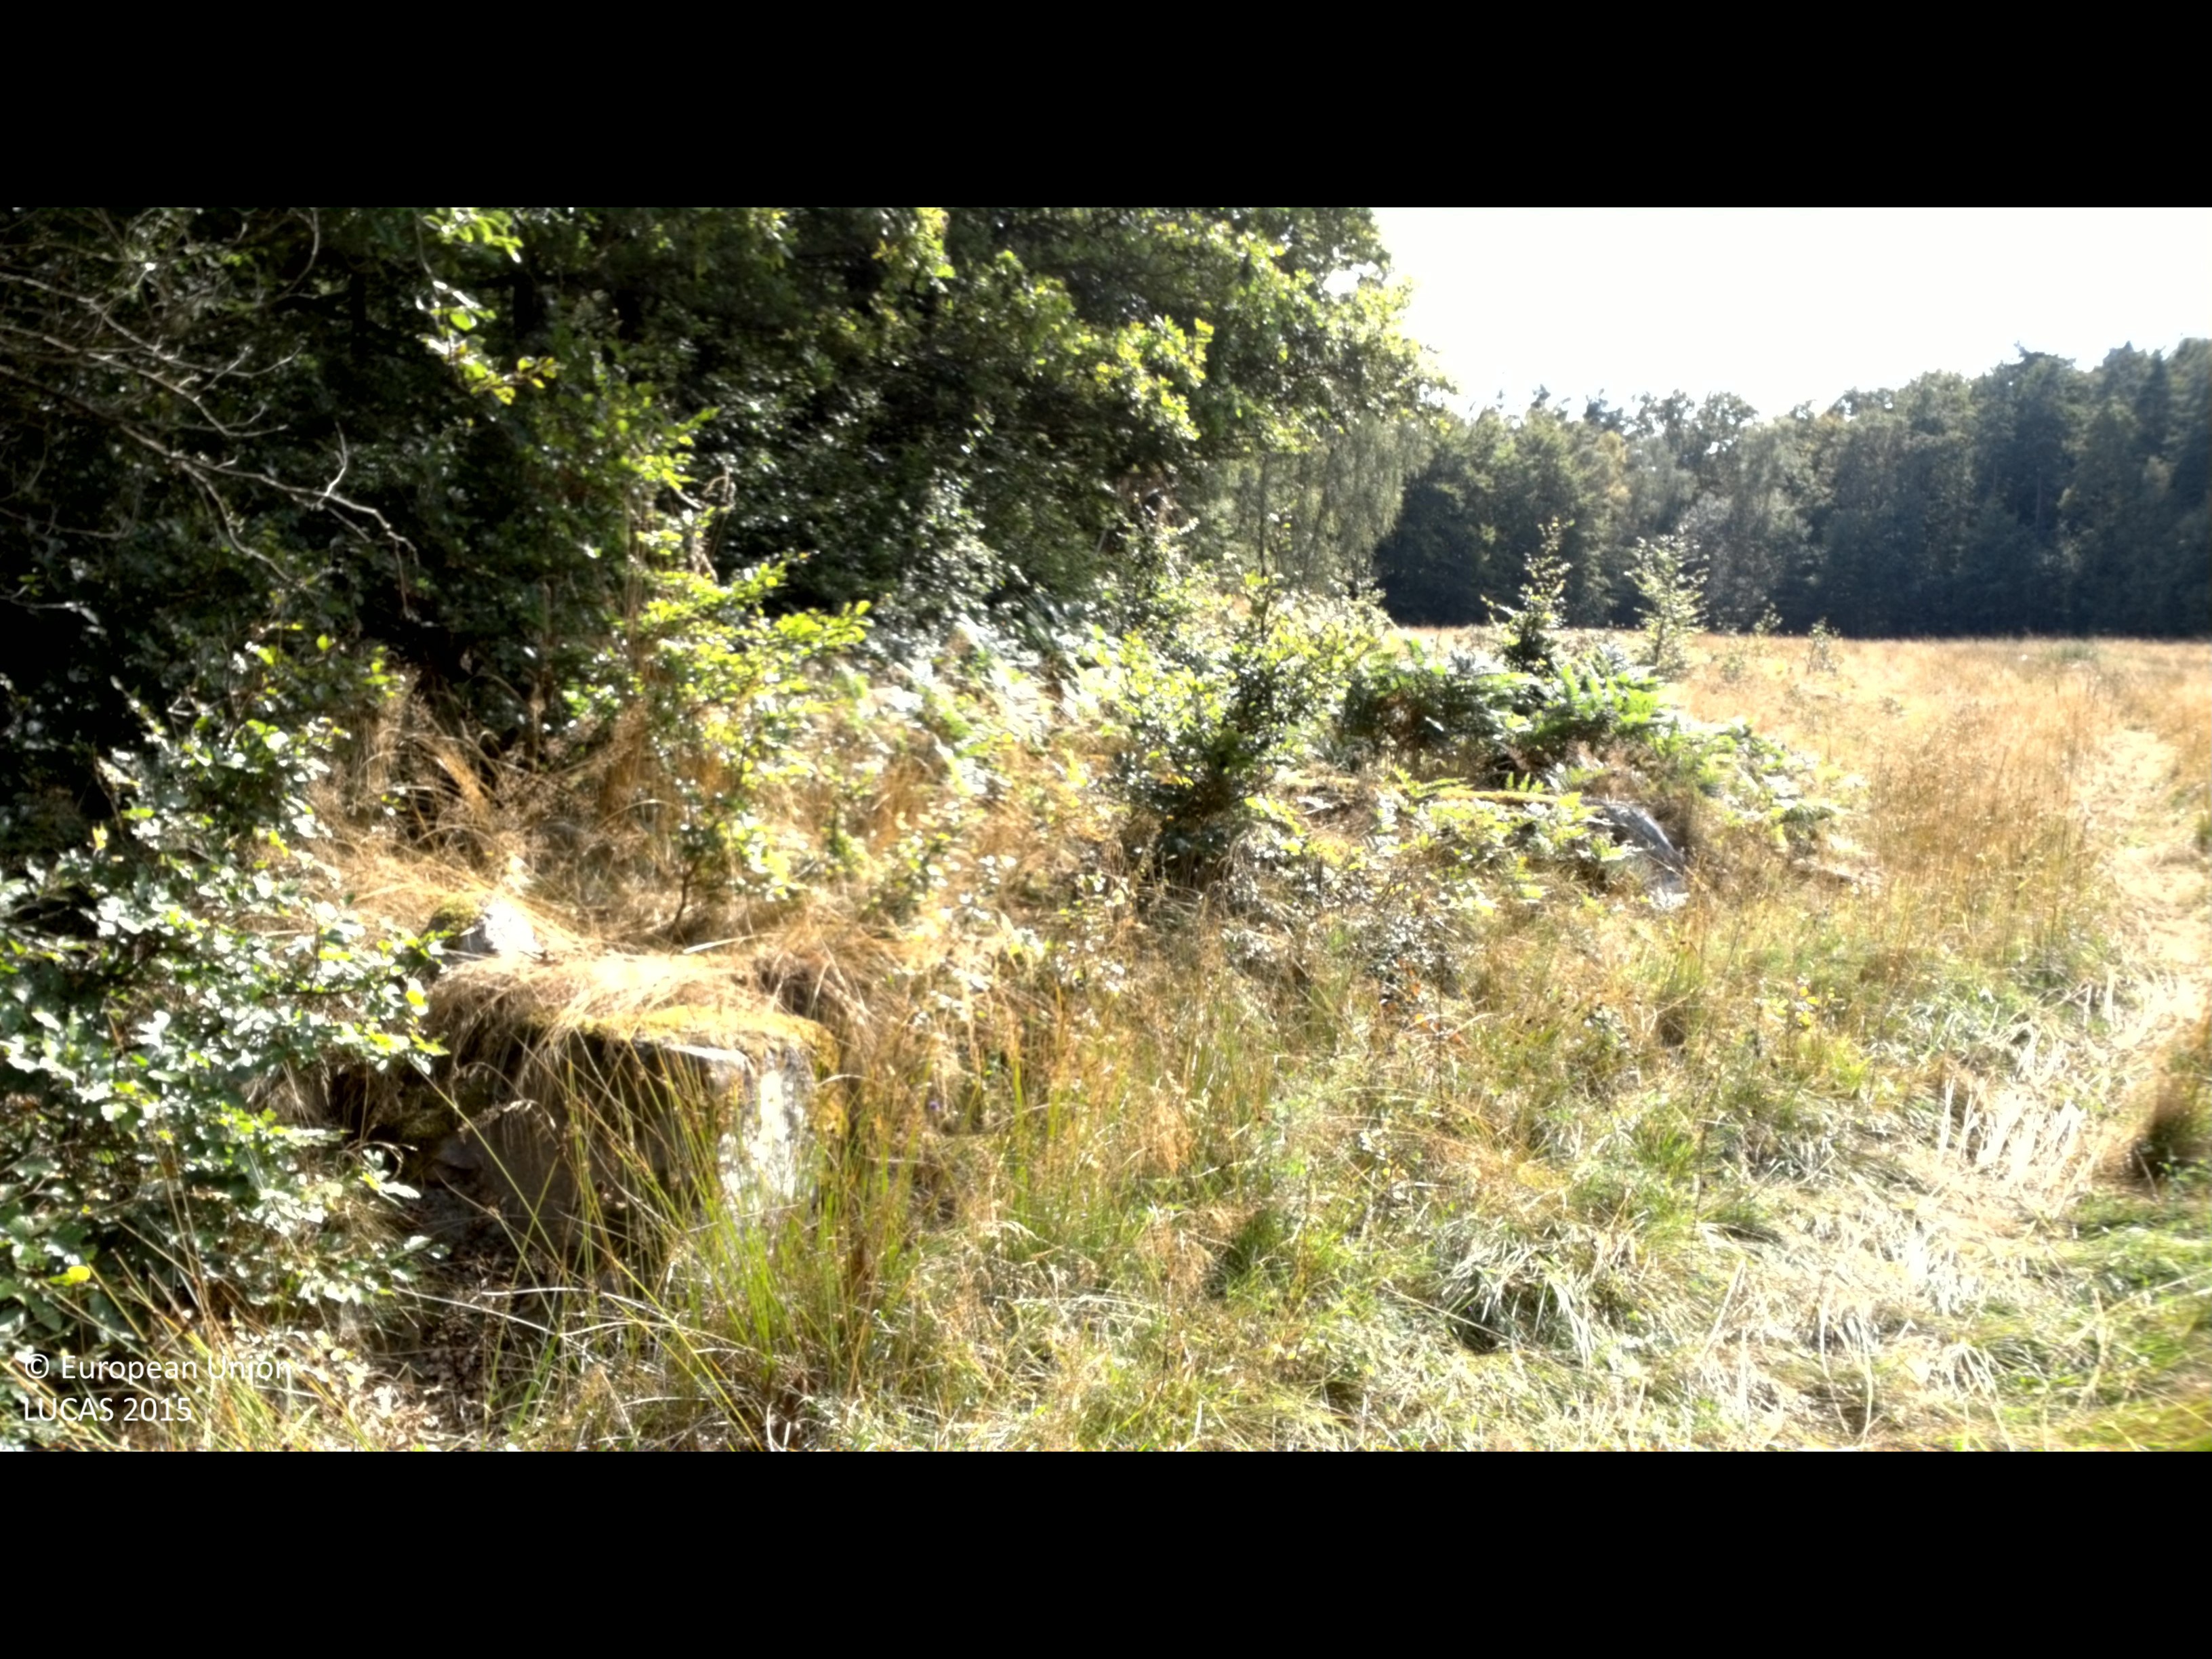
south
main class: Grassland
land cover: Grassland without tree/shrub cover
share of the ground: > 75 %
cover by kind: herbaceous plants 100 %
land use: Agriculture (excluding fallow land and kitchen gardens)
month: August
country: SE
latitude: 56.1887
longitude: 14.7841
